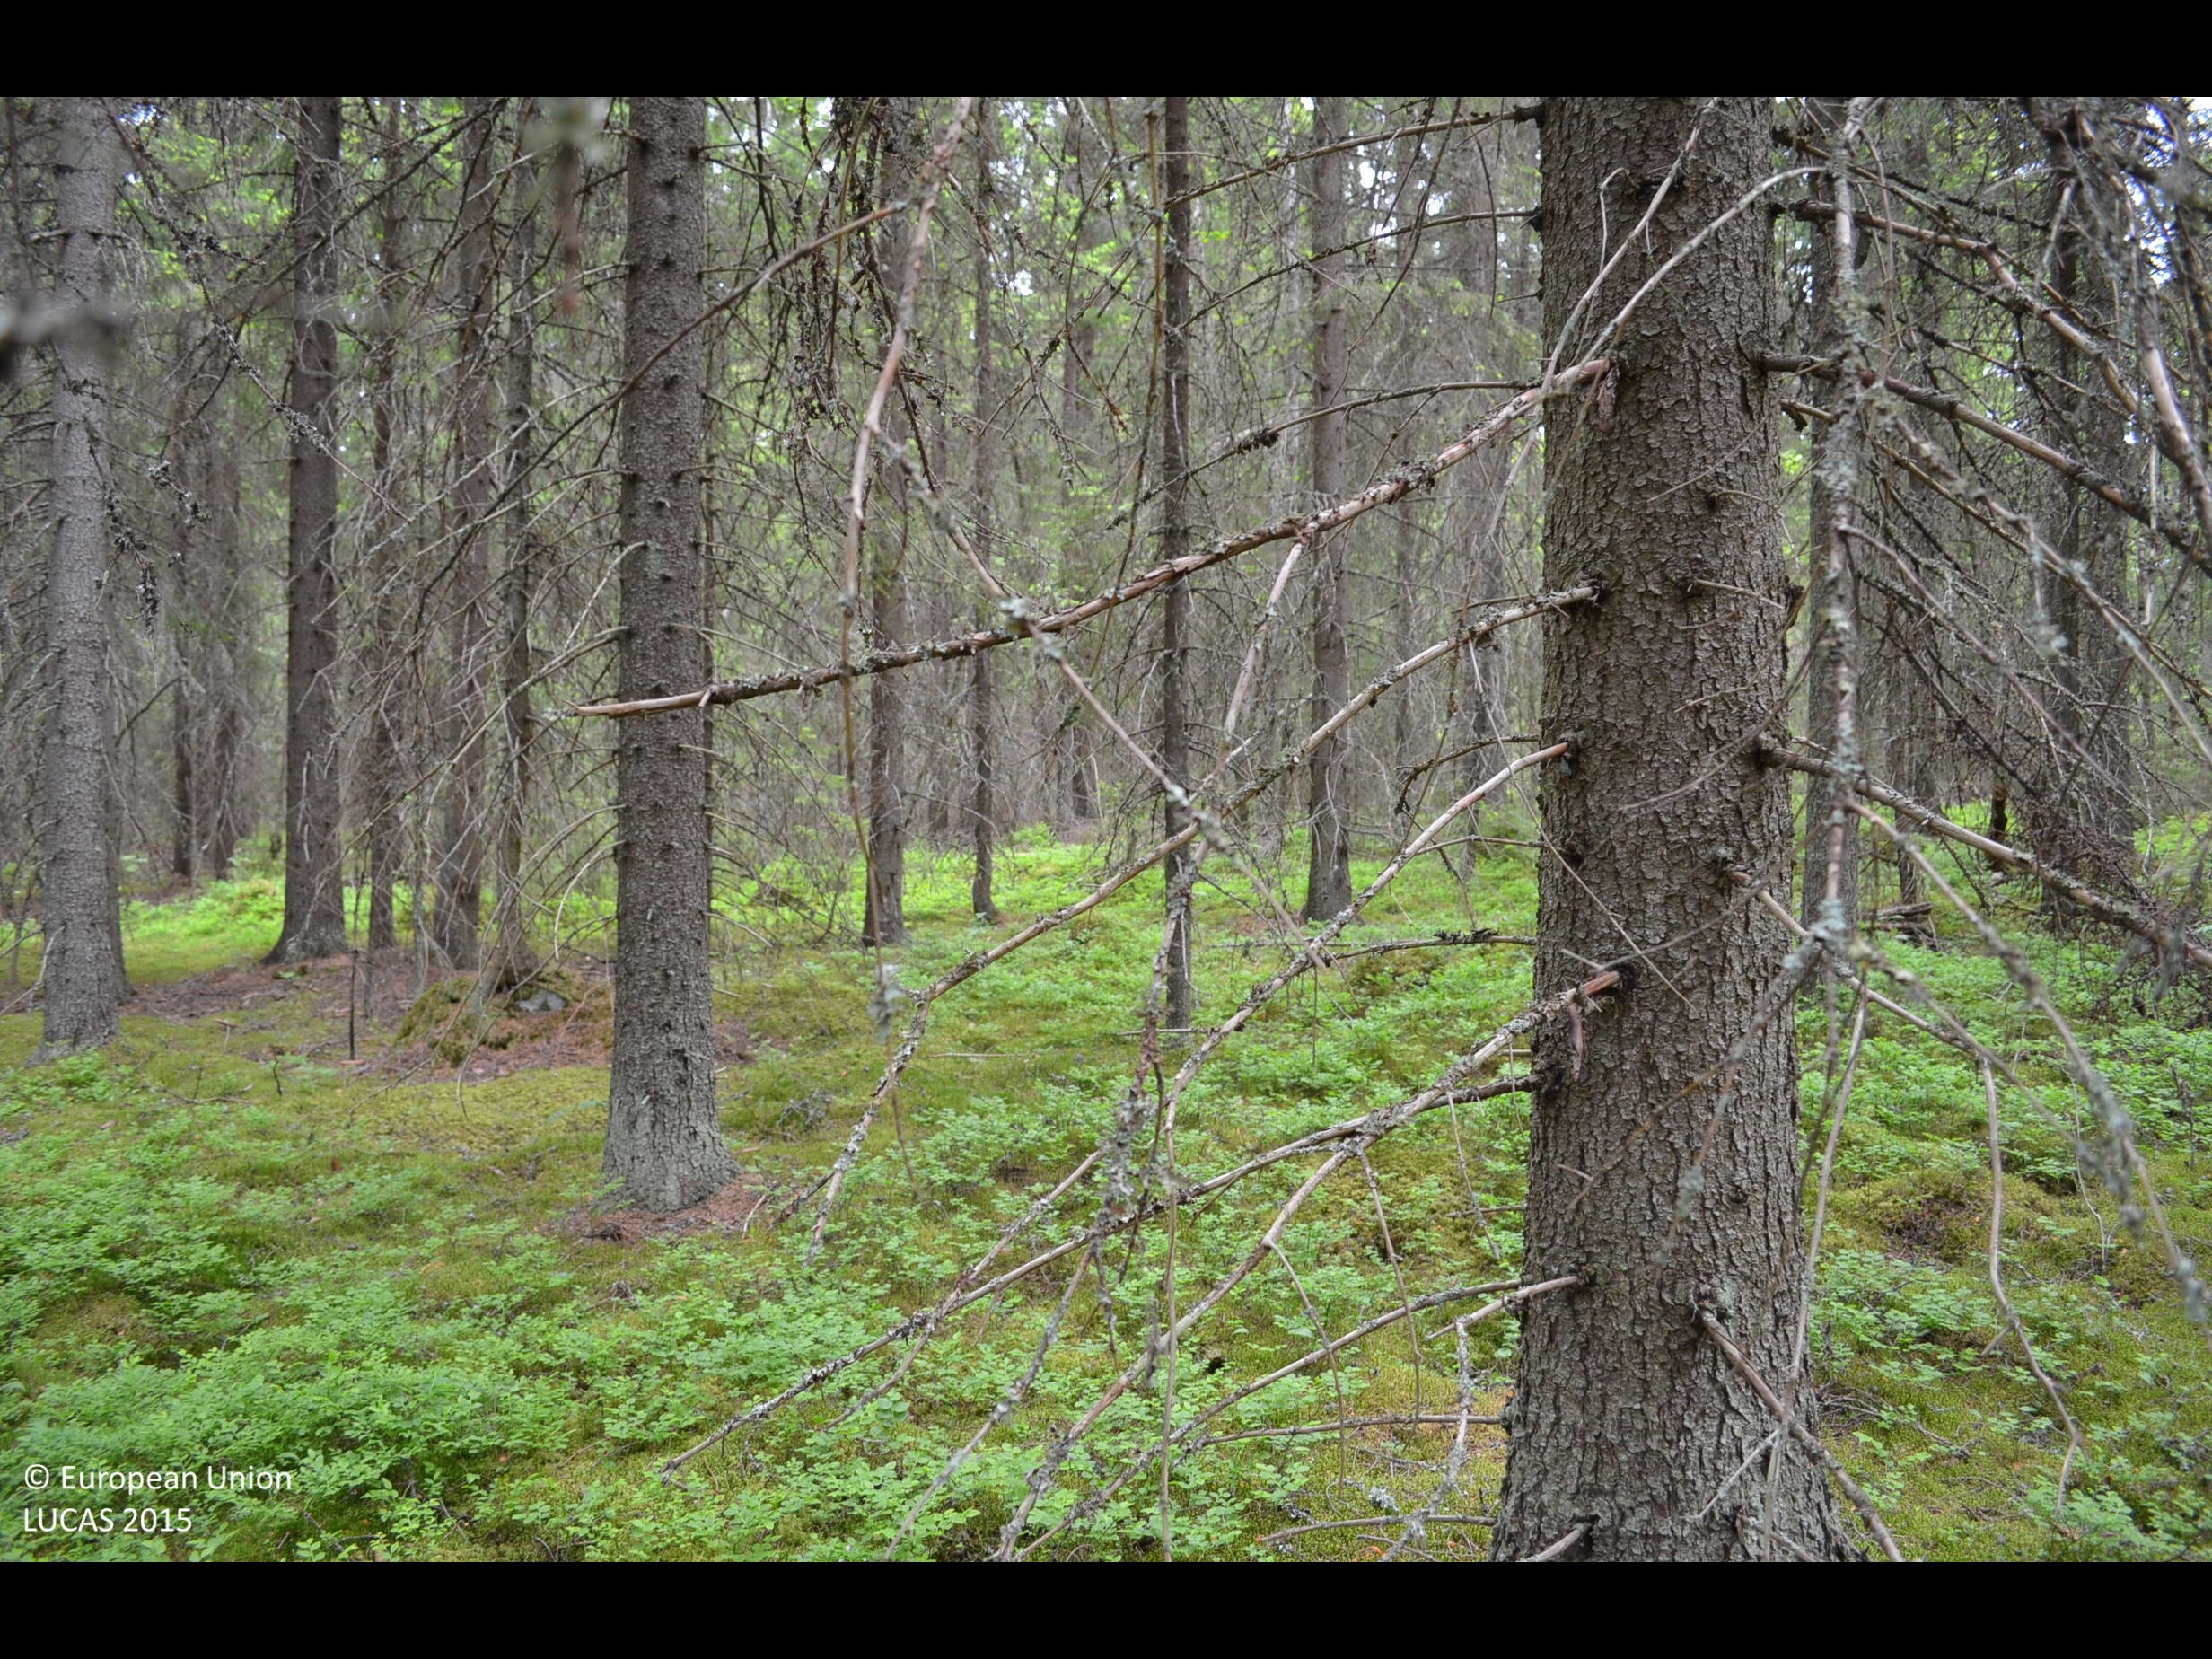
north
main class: Woodland
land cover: Spruce dominated coniferous woodland
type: boreal forest
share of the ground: > 75 %
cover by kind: coniferous forest trees 75 %, shrubs 15 %, broadleaved forest trees 5 %, lichens and mosses 5 %
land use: Forestry
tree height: > 5 m
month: June
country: FI
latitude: 61.9548
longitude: 23.4008
